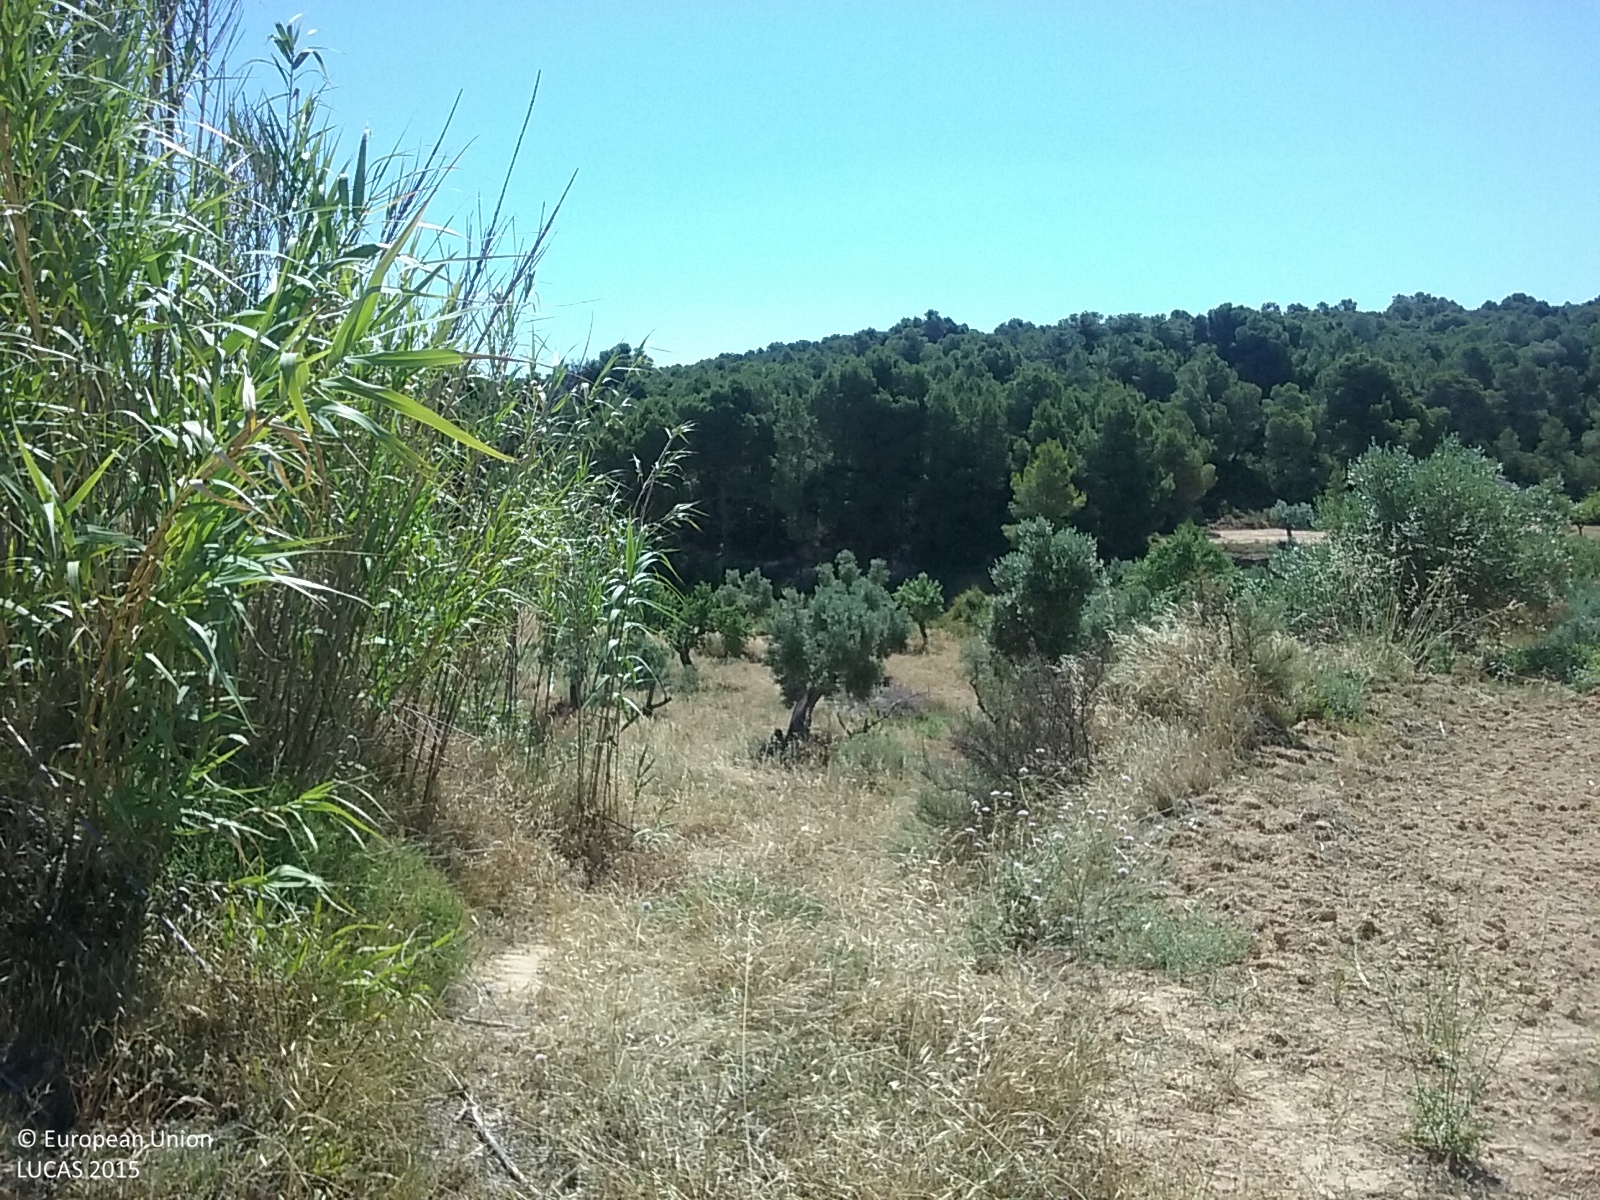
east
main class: Cropland
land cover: Vineyards
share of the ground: 10 - 25 %
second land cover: Other bare soil
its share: > 75 %
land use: Agriculture (excluding fallow land and kitchen gardens)
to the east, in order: Grass margins; Shrubland with sparse tree cover; Vineyards; Shrubland with sparse tree cover; Tracks; Dry stone walls; Olive groves; Dry stone walls; Olive groves; Pine dominated coniferous woodland; Dry stone walls; Shrubland with sparse tree cover; Dry stone walls
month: June
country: ES
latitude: 41.0794
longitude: 0.3137
